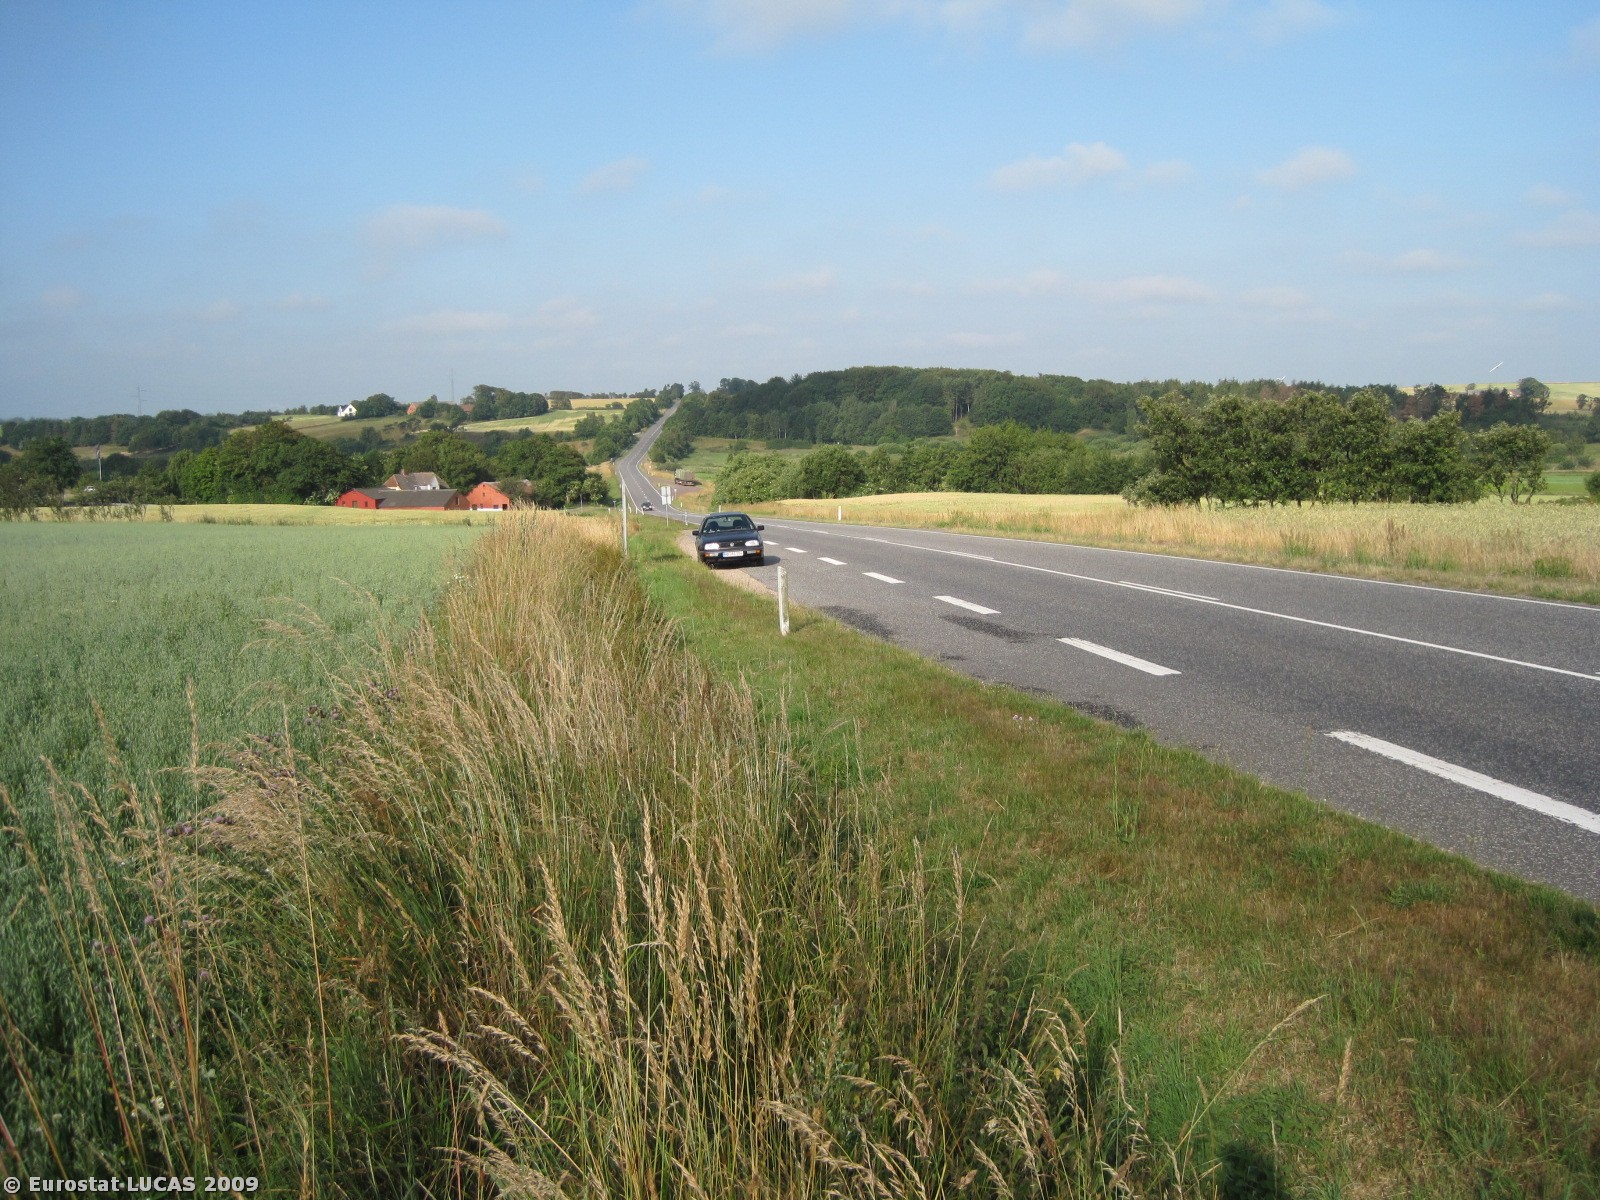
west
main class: Grassland
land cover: Grassland without tree/shrub cover
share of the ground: > 75 %
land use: Unused
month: July
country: DK
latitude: 56.4514
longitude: 8.7523
